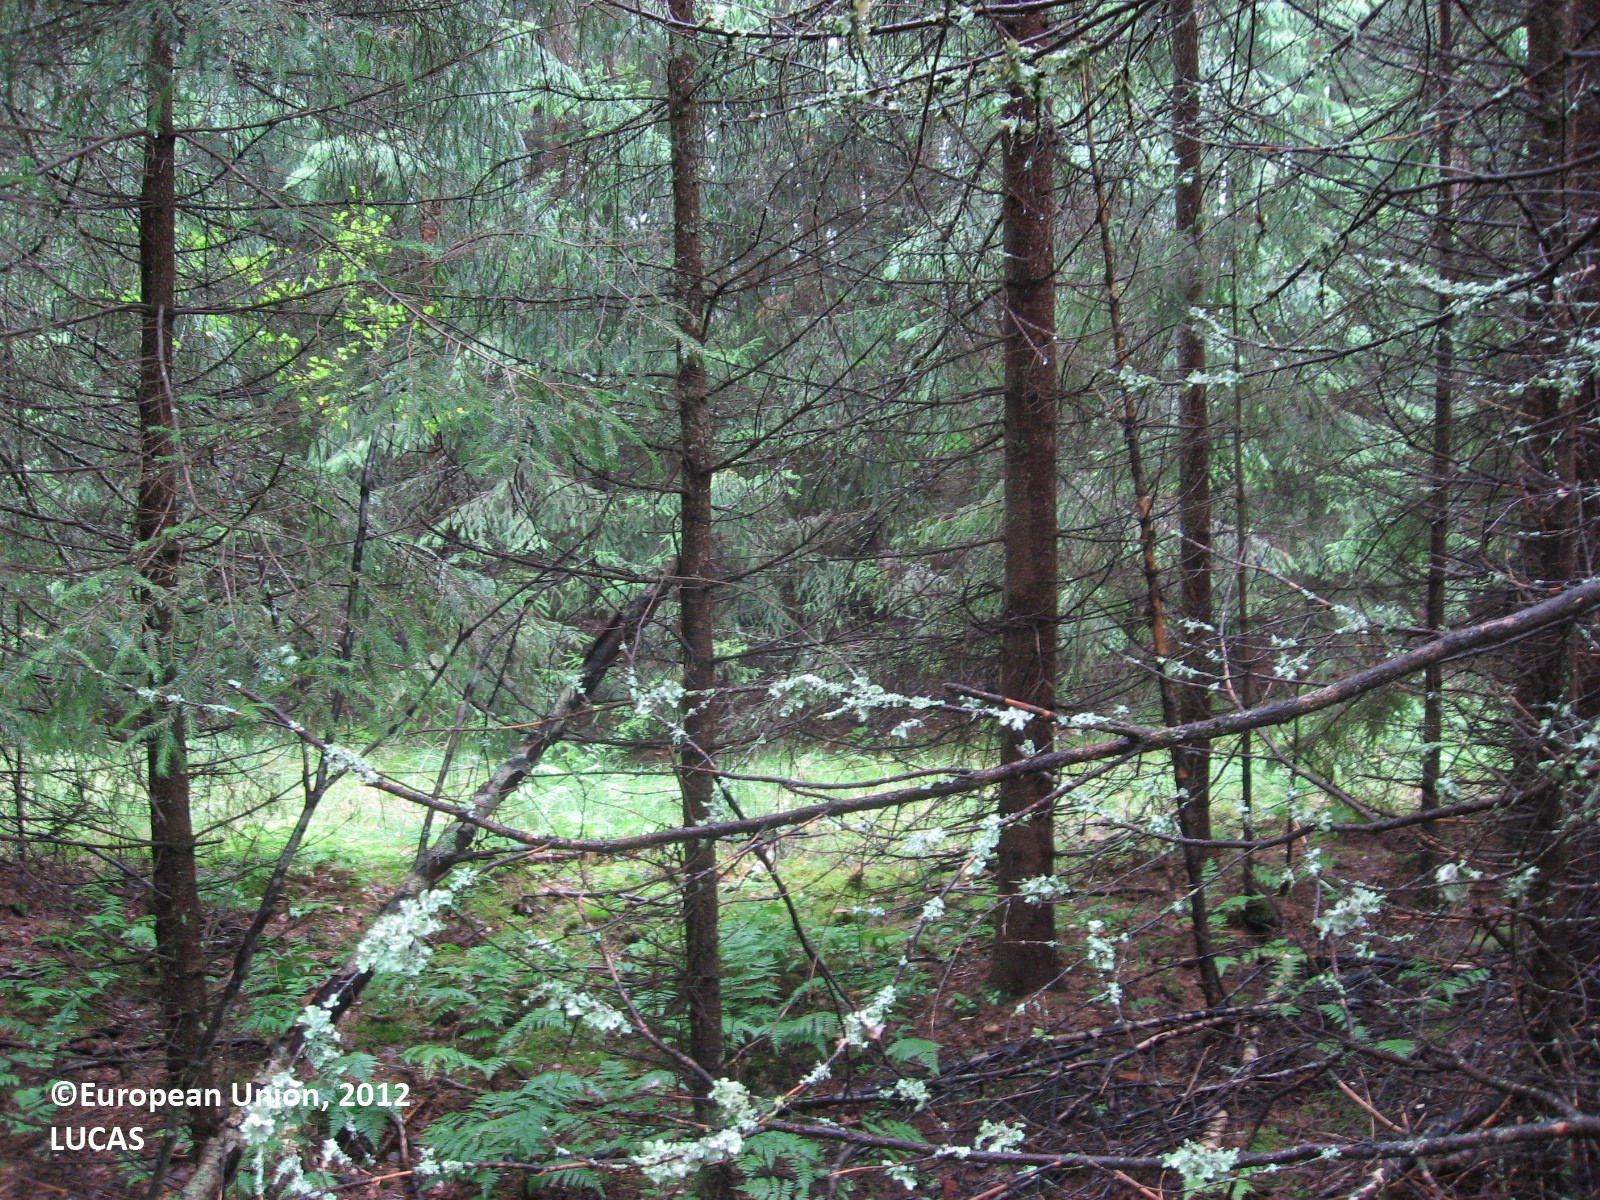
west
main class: Woodland
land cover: Spruce dominated mixed woodland
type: boreal forest
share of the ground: > 75 %
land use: Forestry
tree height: > 5 m
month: August
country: FI
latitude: 61.0692
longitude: 24.7659
